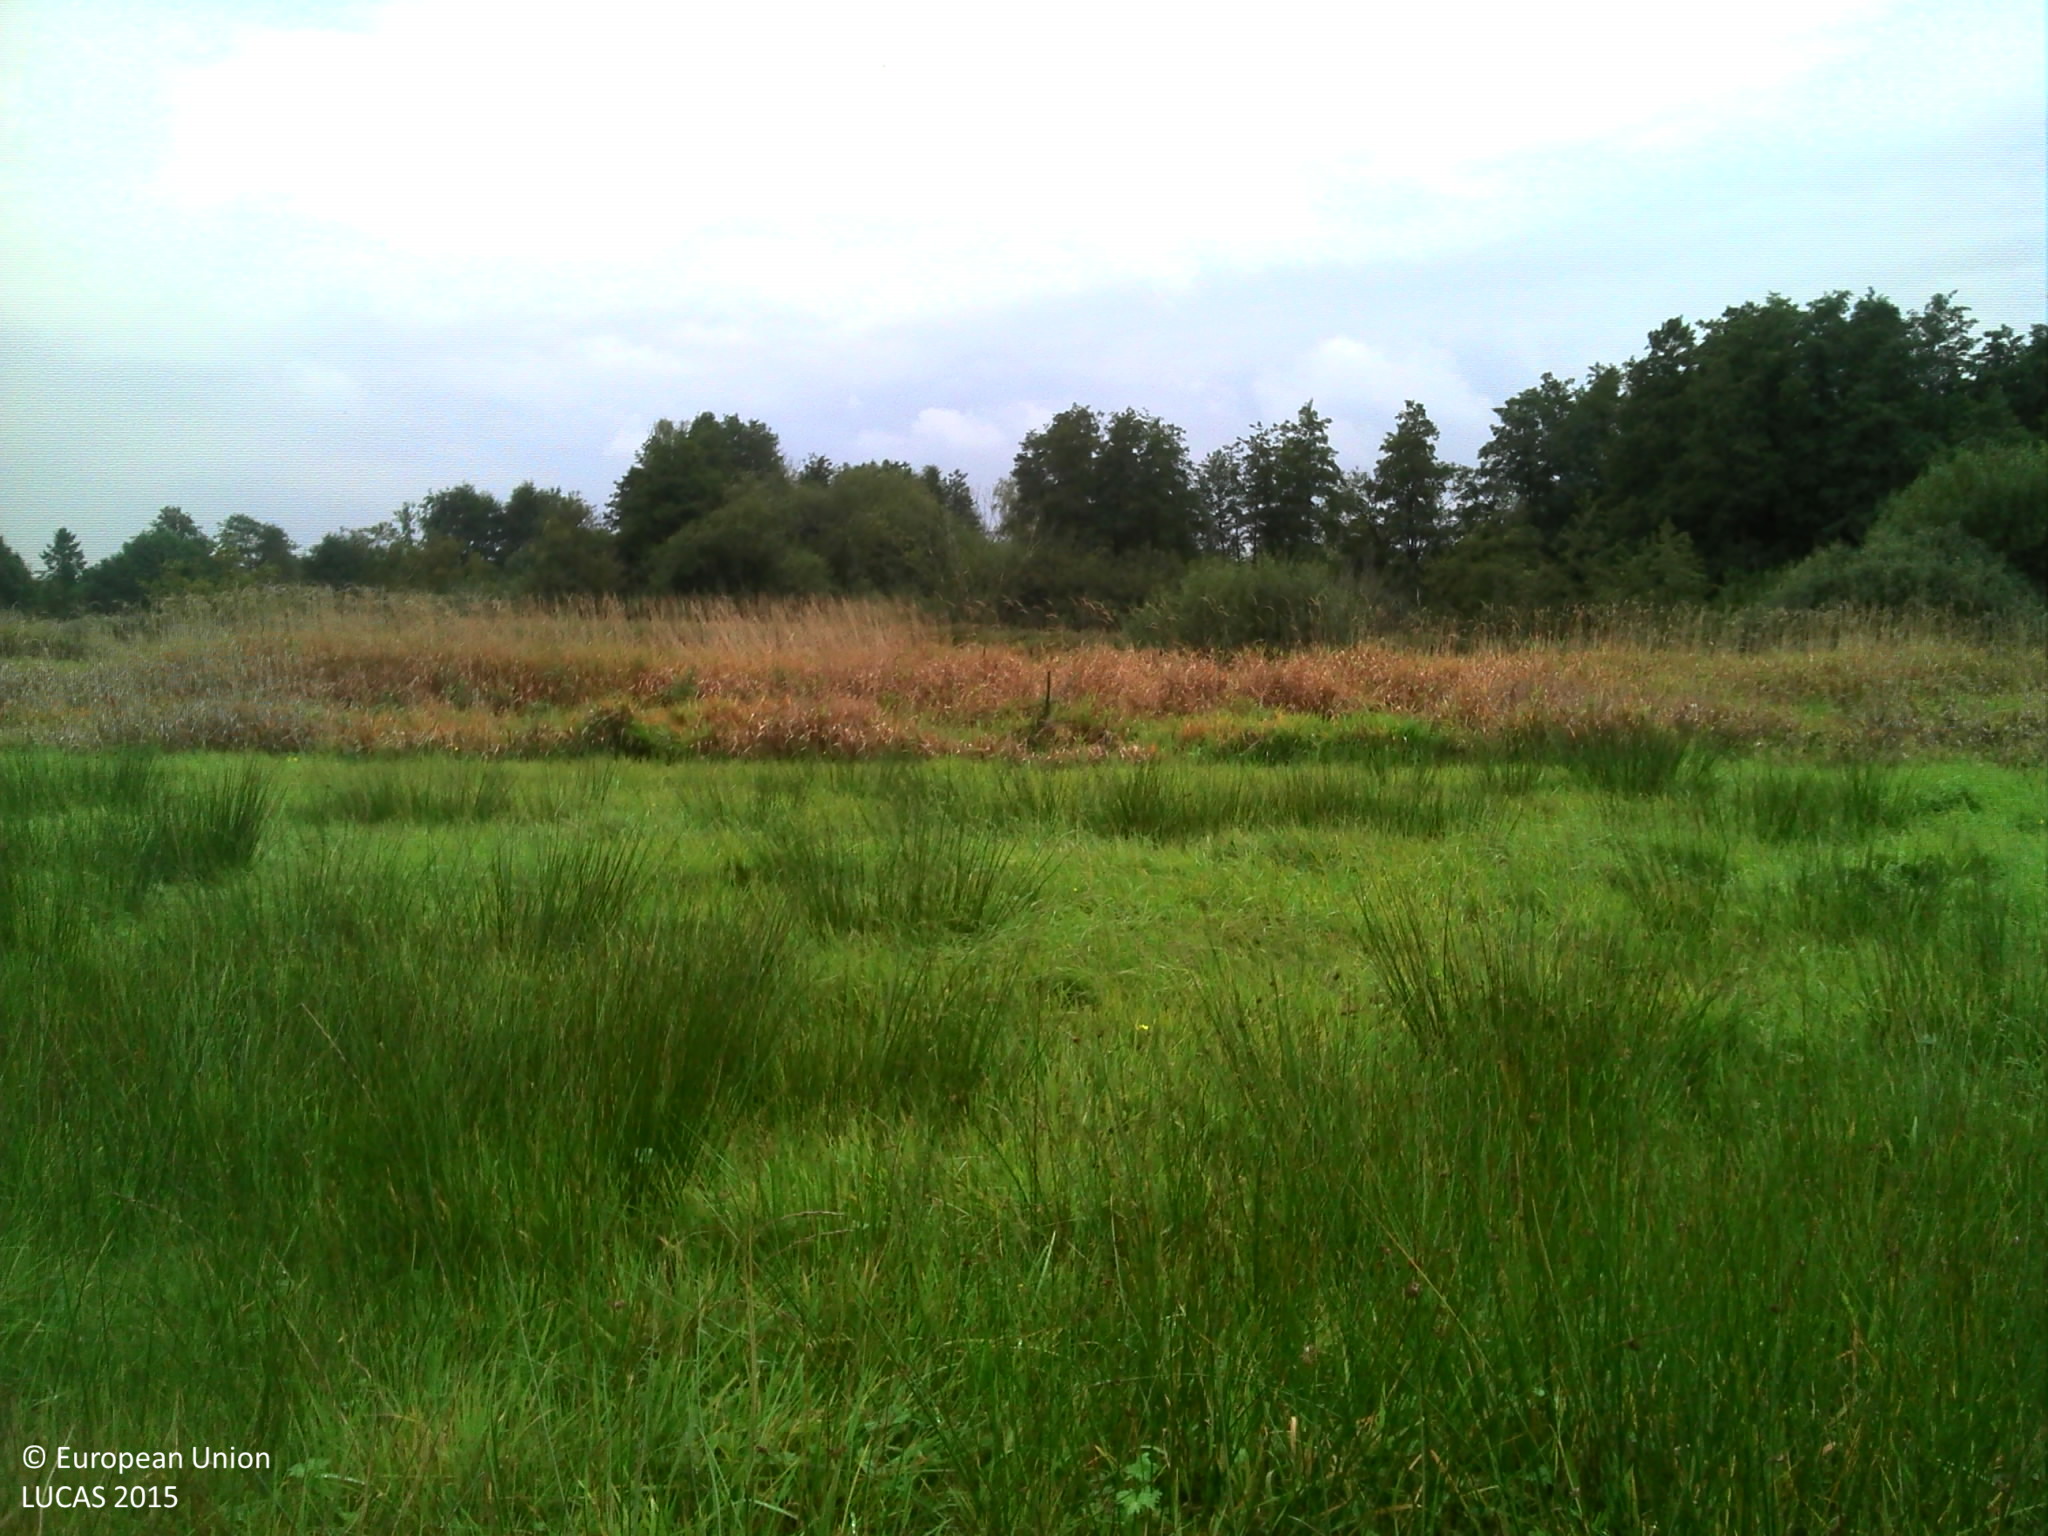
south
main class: Grassland
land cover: Grassland without tree/shrub cover
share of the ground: > 75 %
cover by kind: herbaceous plants 100 %
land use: Agriculture (excluding fallow land and kitchen gardens)
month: October
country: BE
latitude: 51.1451
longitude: 5.1803
